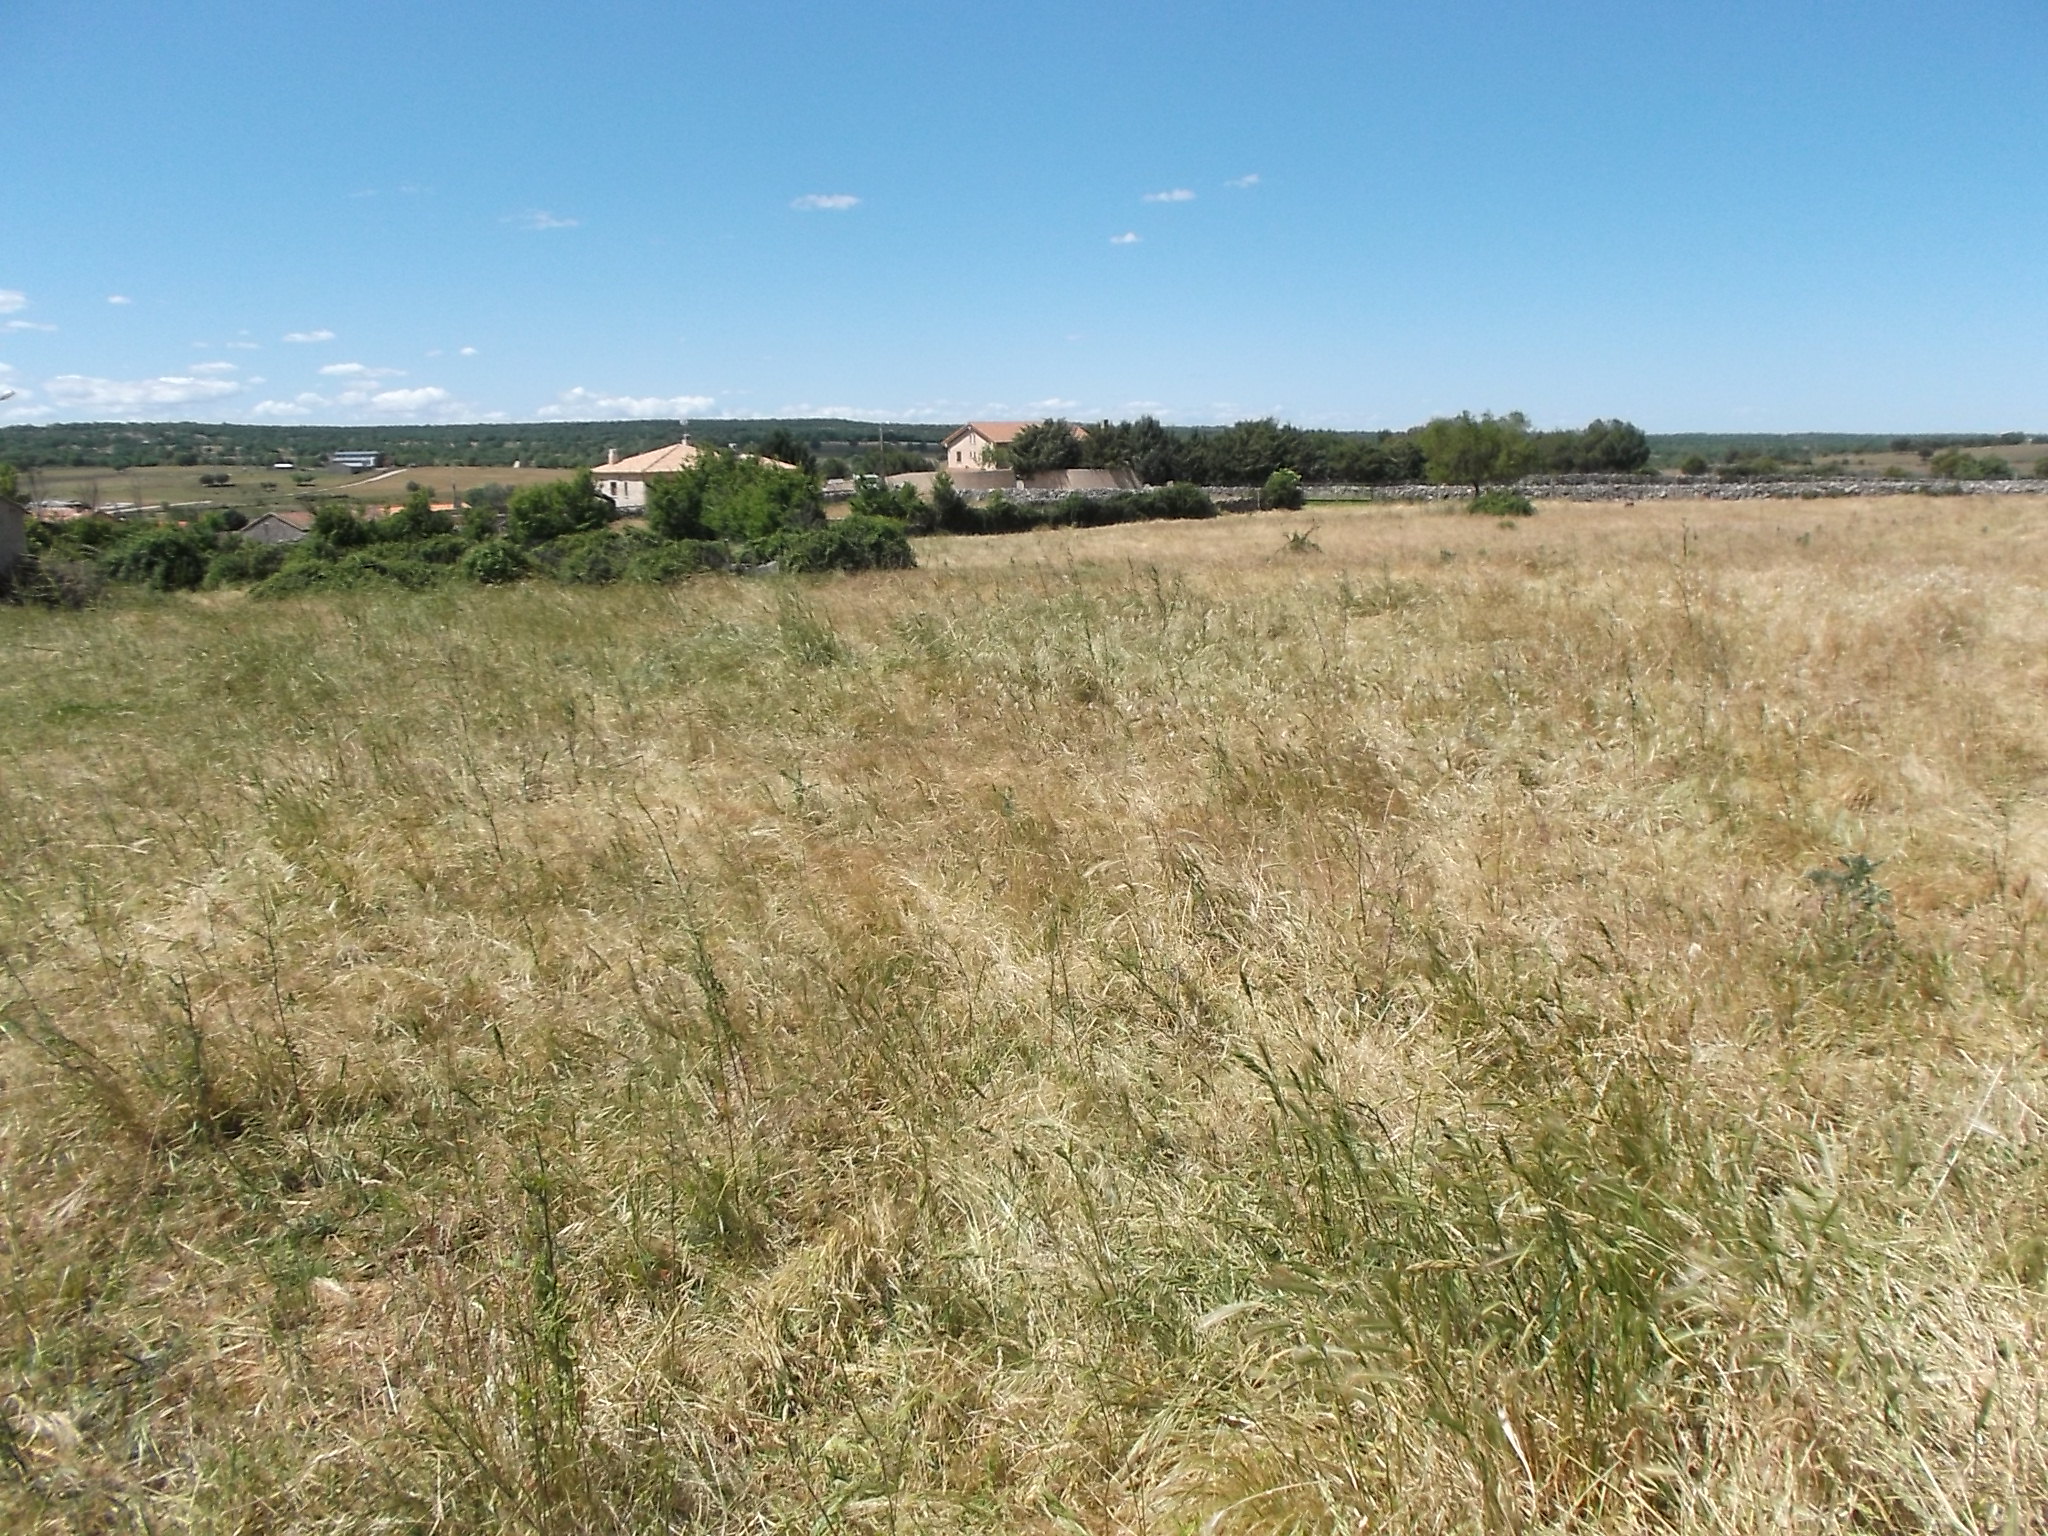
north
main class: Grassland
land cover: Grassland without tree/shrub cover
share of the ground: > 75 %
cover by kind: herbaceous plants 100 %
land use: Agriculture (excluding fallow land and kitchen gardens)
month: May
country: ES
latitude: 40.9619
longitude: -6.2604
